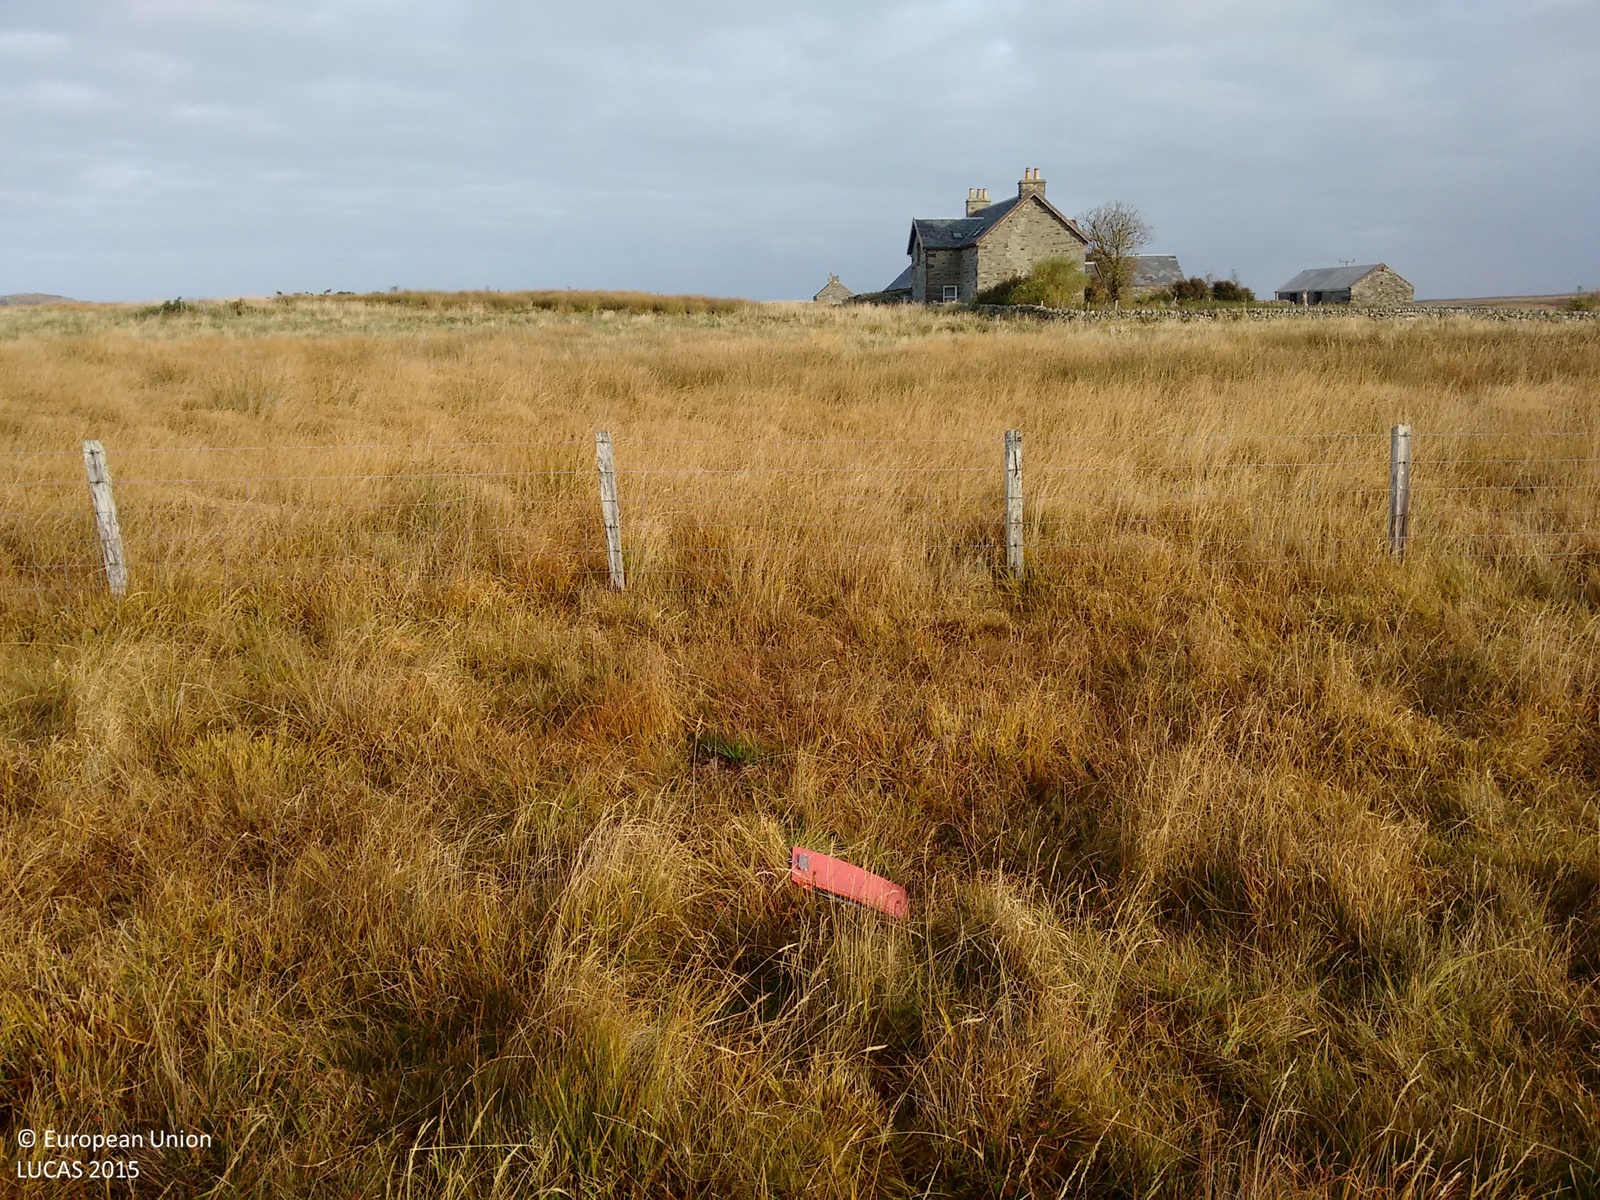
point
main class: Grassland
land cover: Grassland without tree/shrub cover
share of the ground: > 75 %
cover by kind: herbaceous plants 85 %, lichens and mosses 10 %, shrubs 5 %
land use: Agriculture (excluding fallow land and kitchen gardens)
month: October
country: GB
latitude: 55.8365
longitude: -6.4192
